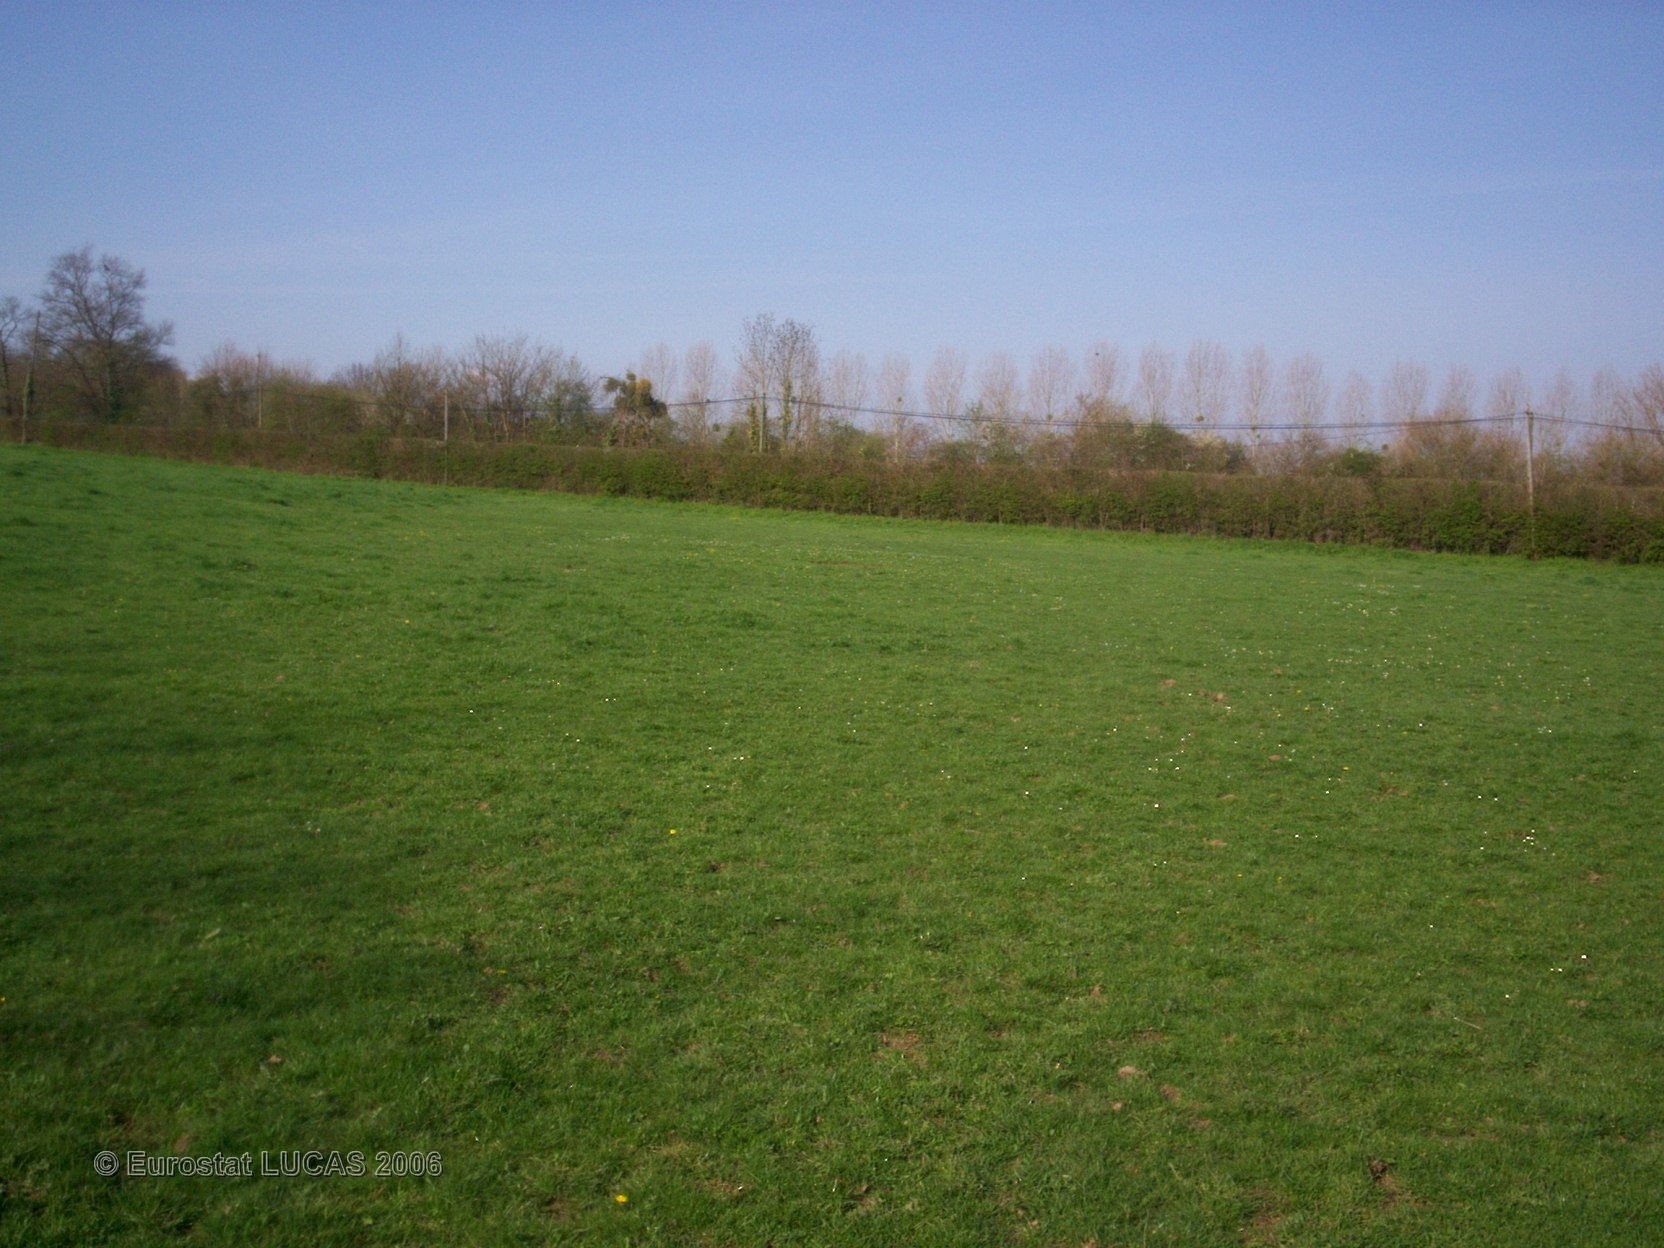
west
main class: Grassland
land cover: Grassland without tree/shrub cover
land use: Agriculture (excluding fallow land and kitchen gardens)
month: April
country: FR
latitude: 49.0720
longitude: -0.0100
